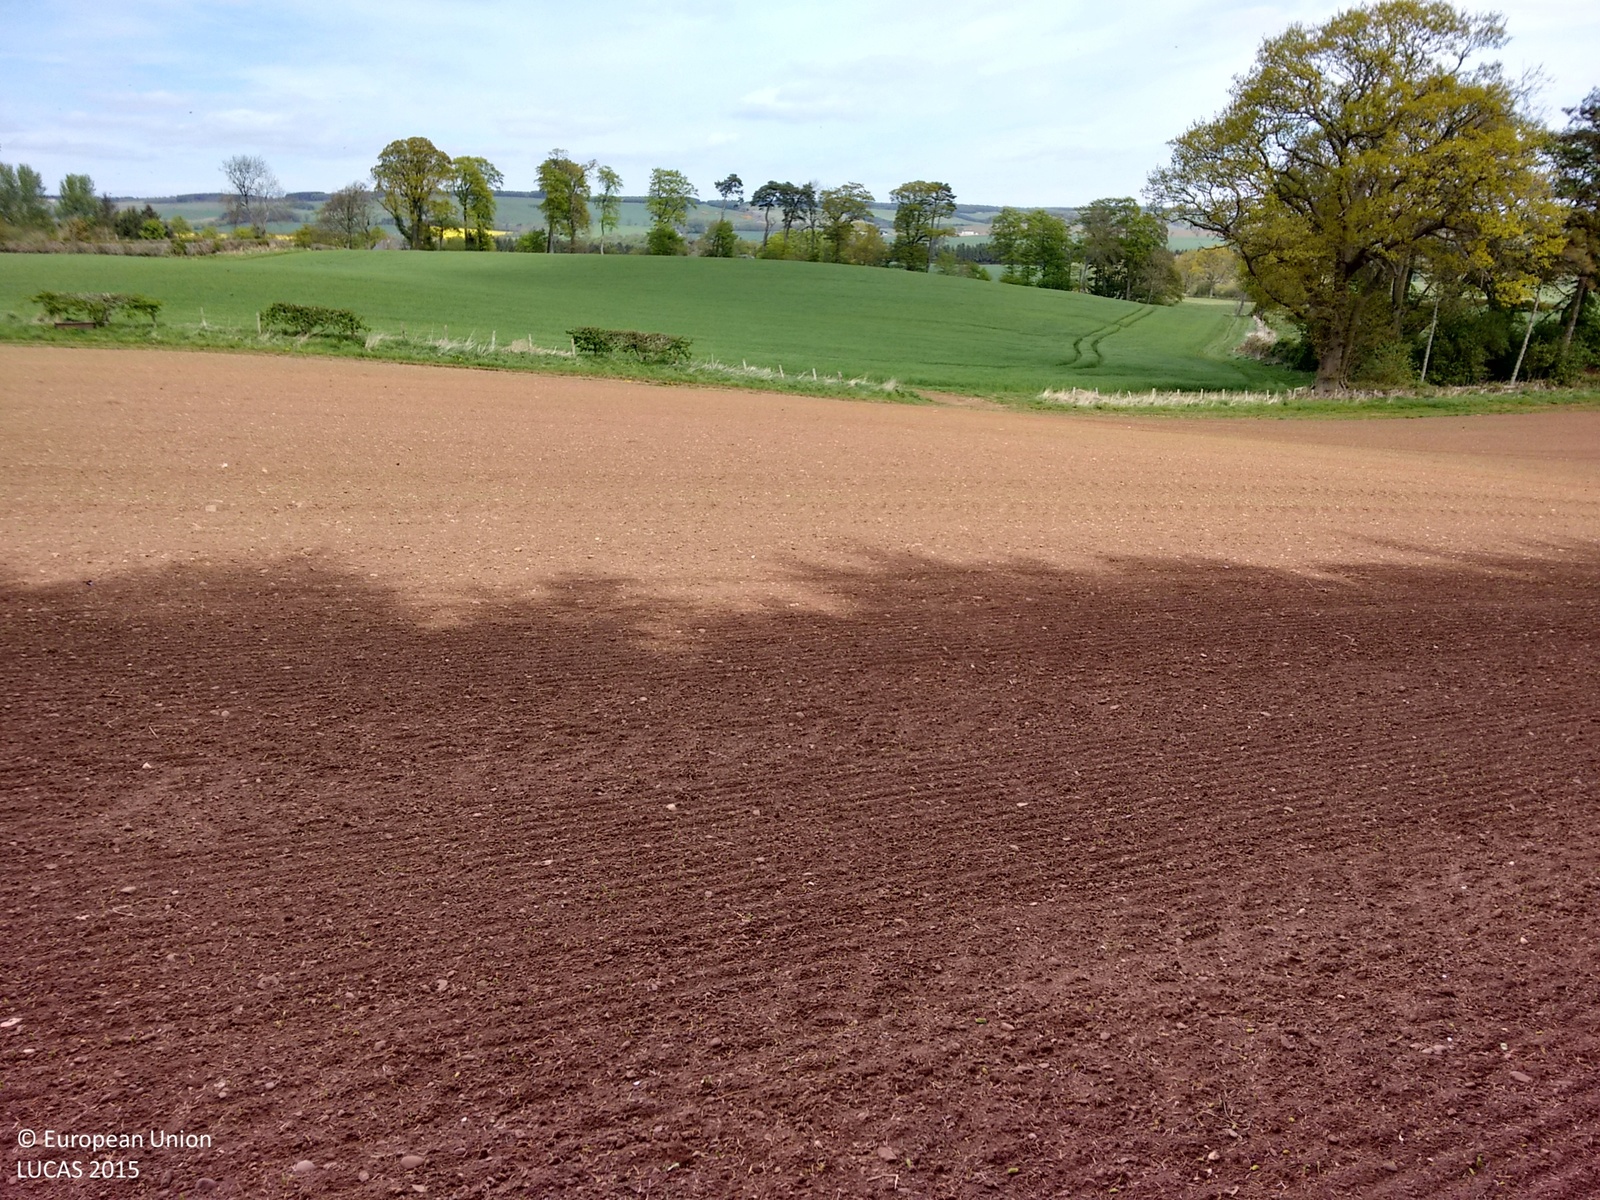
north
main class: Cropland
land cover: Dry pulses
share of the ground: < 10 %
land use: Agriculture (excluding fallow land and kitchen gardens)
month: May
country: GB
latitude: 55.7914
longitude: -2.3218
